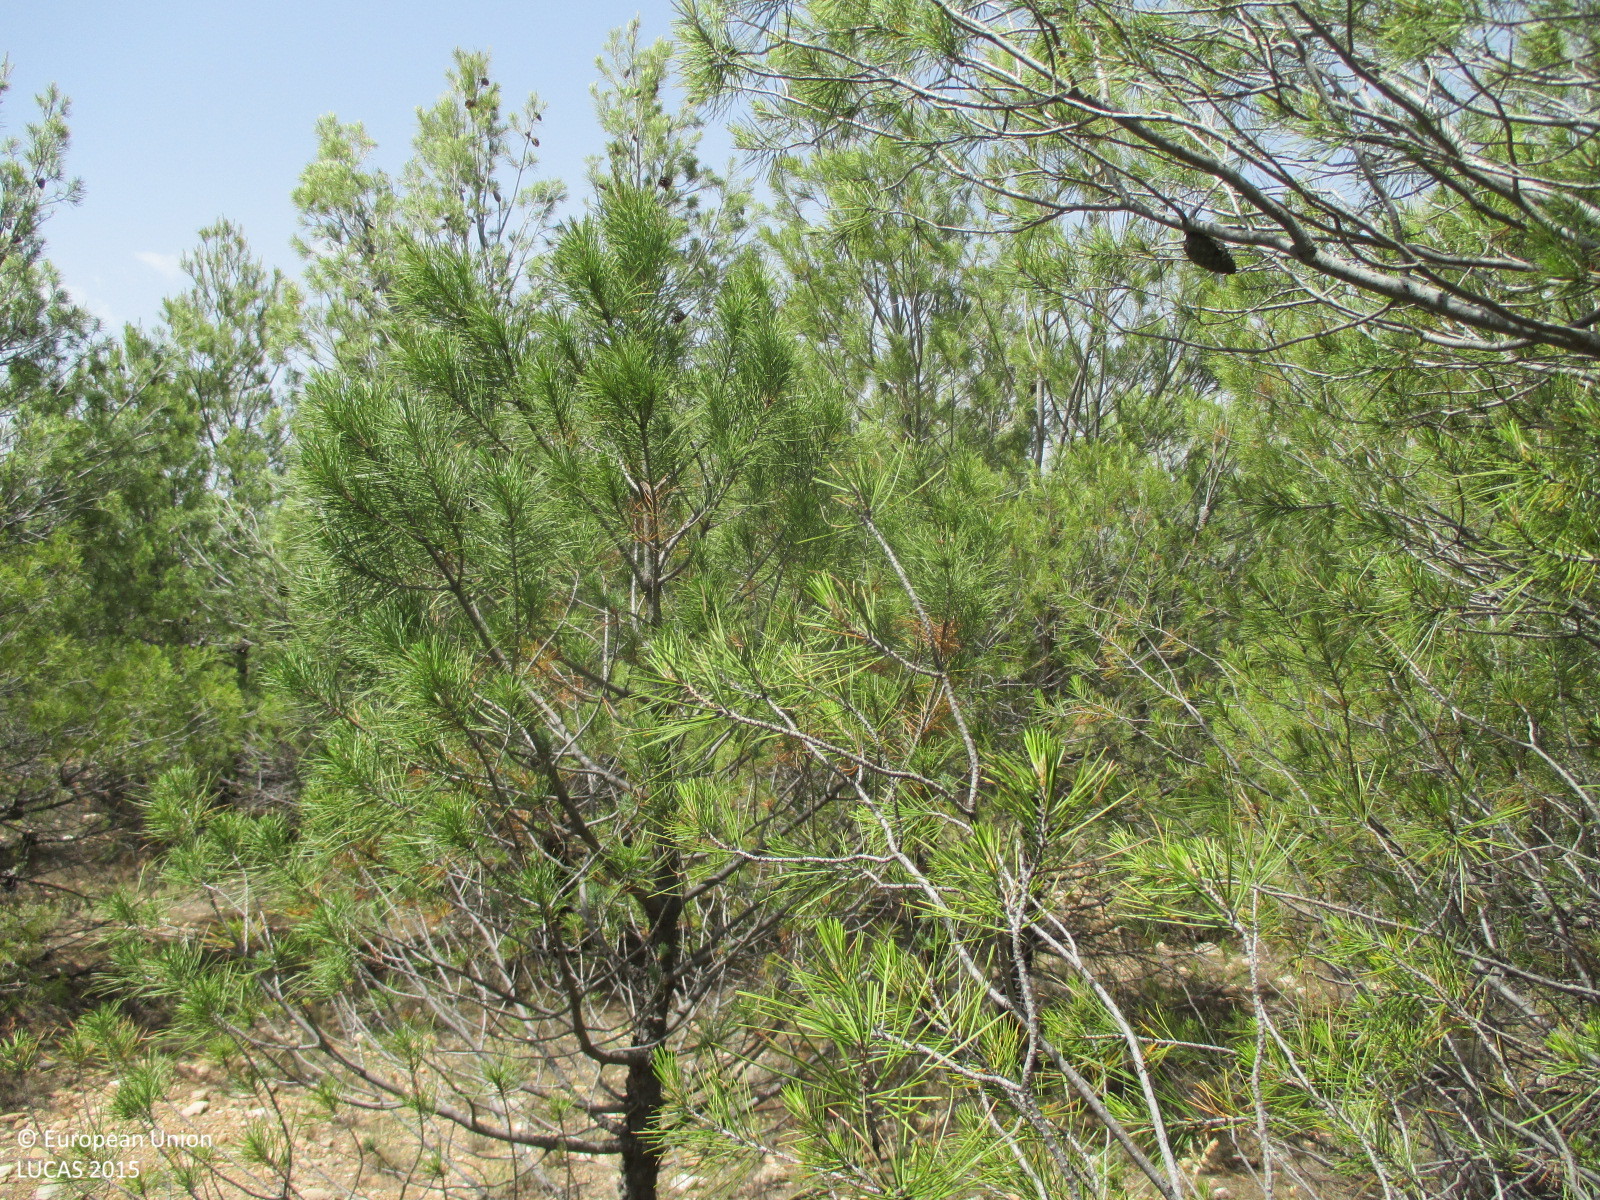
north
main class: Woodland
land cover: Pine dominated coniferous woodland
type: coniferous forest of the mediterranean region
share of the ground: > 75 %
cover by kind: coniferous forest trees 90 %, unconsolidated bare surface 10 %
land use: Forestry
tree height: < 5 m
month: June
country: ES
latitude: 37.6655
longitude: -2.4004
